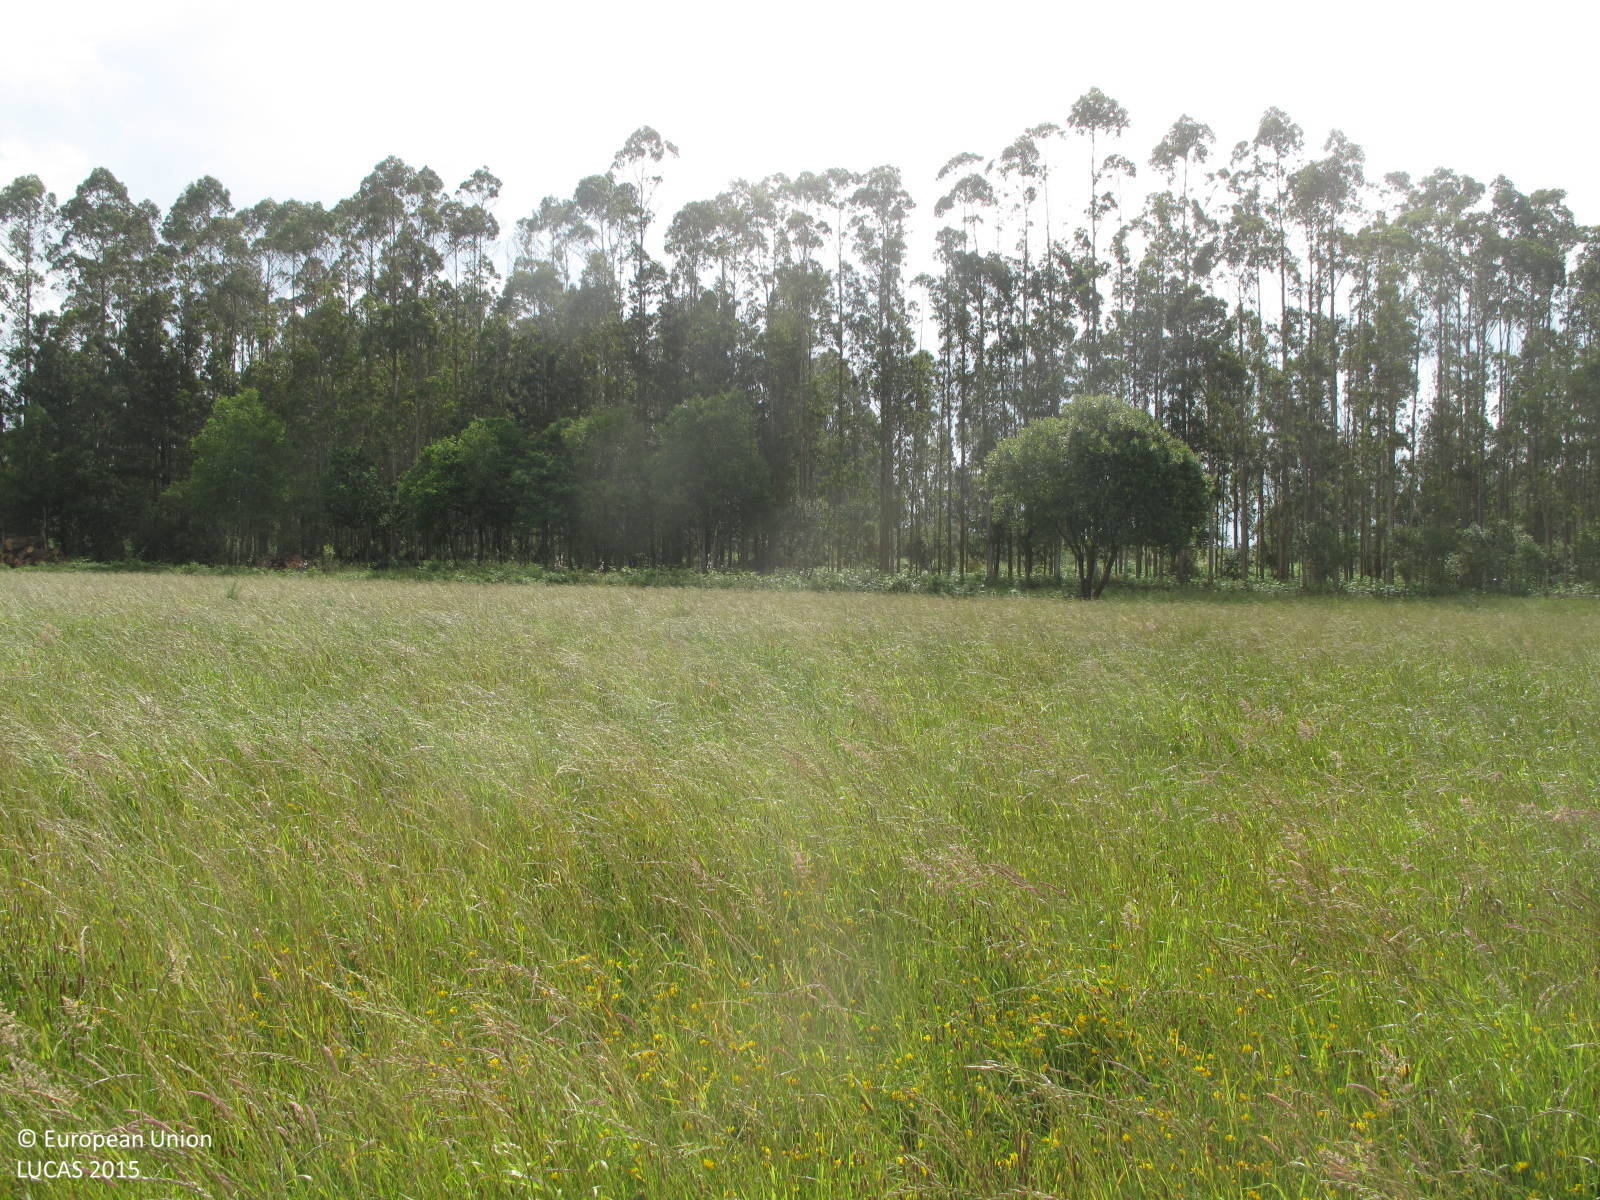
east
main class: Grassland
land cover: Grassland without tree/shrub cover
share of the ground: > 75 %
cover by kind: herbaceous plants 100 %
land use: Agriculture (excluding fallow land and kitchen gardens)
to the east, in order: Grassland without tree/shrub cover; Shrubland without tree cover; Broadleaved woodland; Tracks; Broadleaved woodland; Grassland without tree/shrub cover
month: June
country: ES
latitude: 43.1289
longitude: -8.6104
